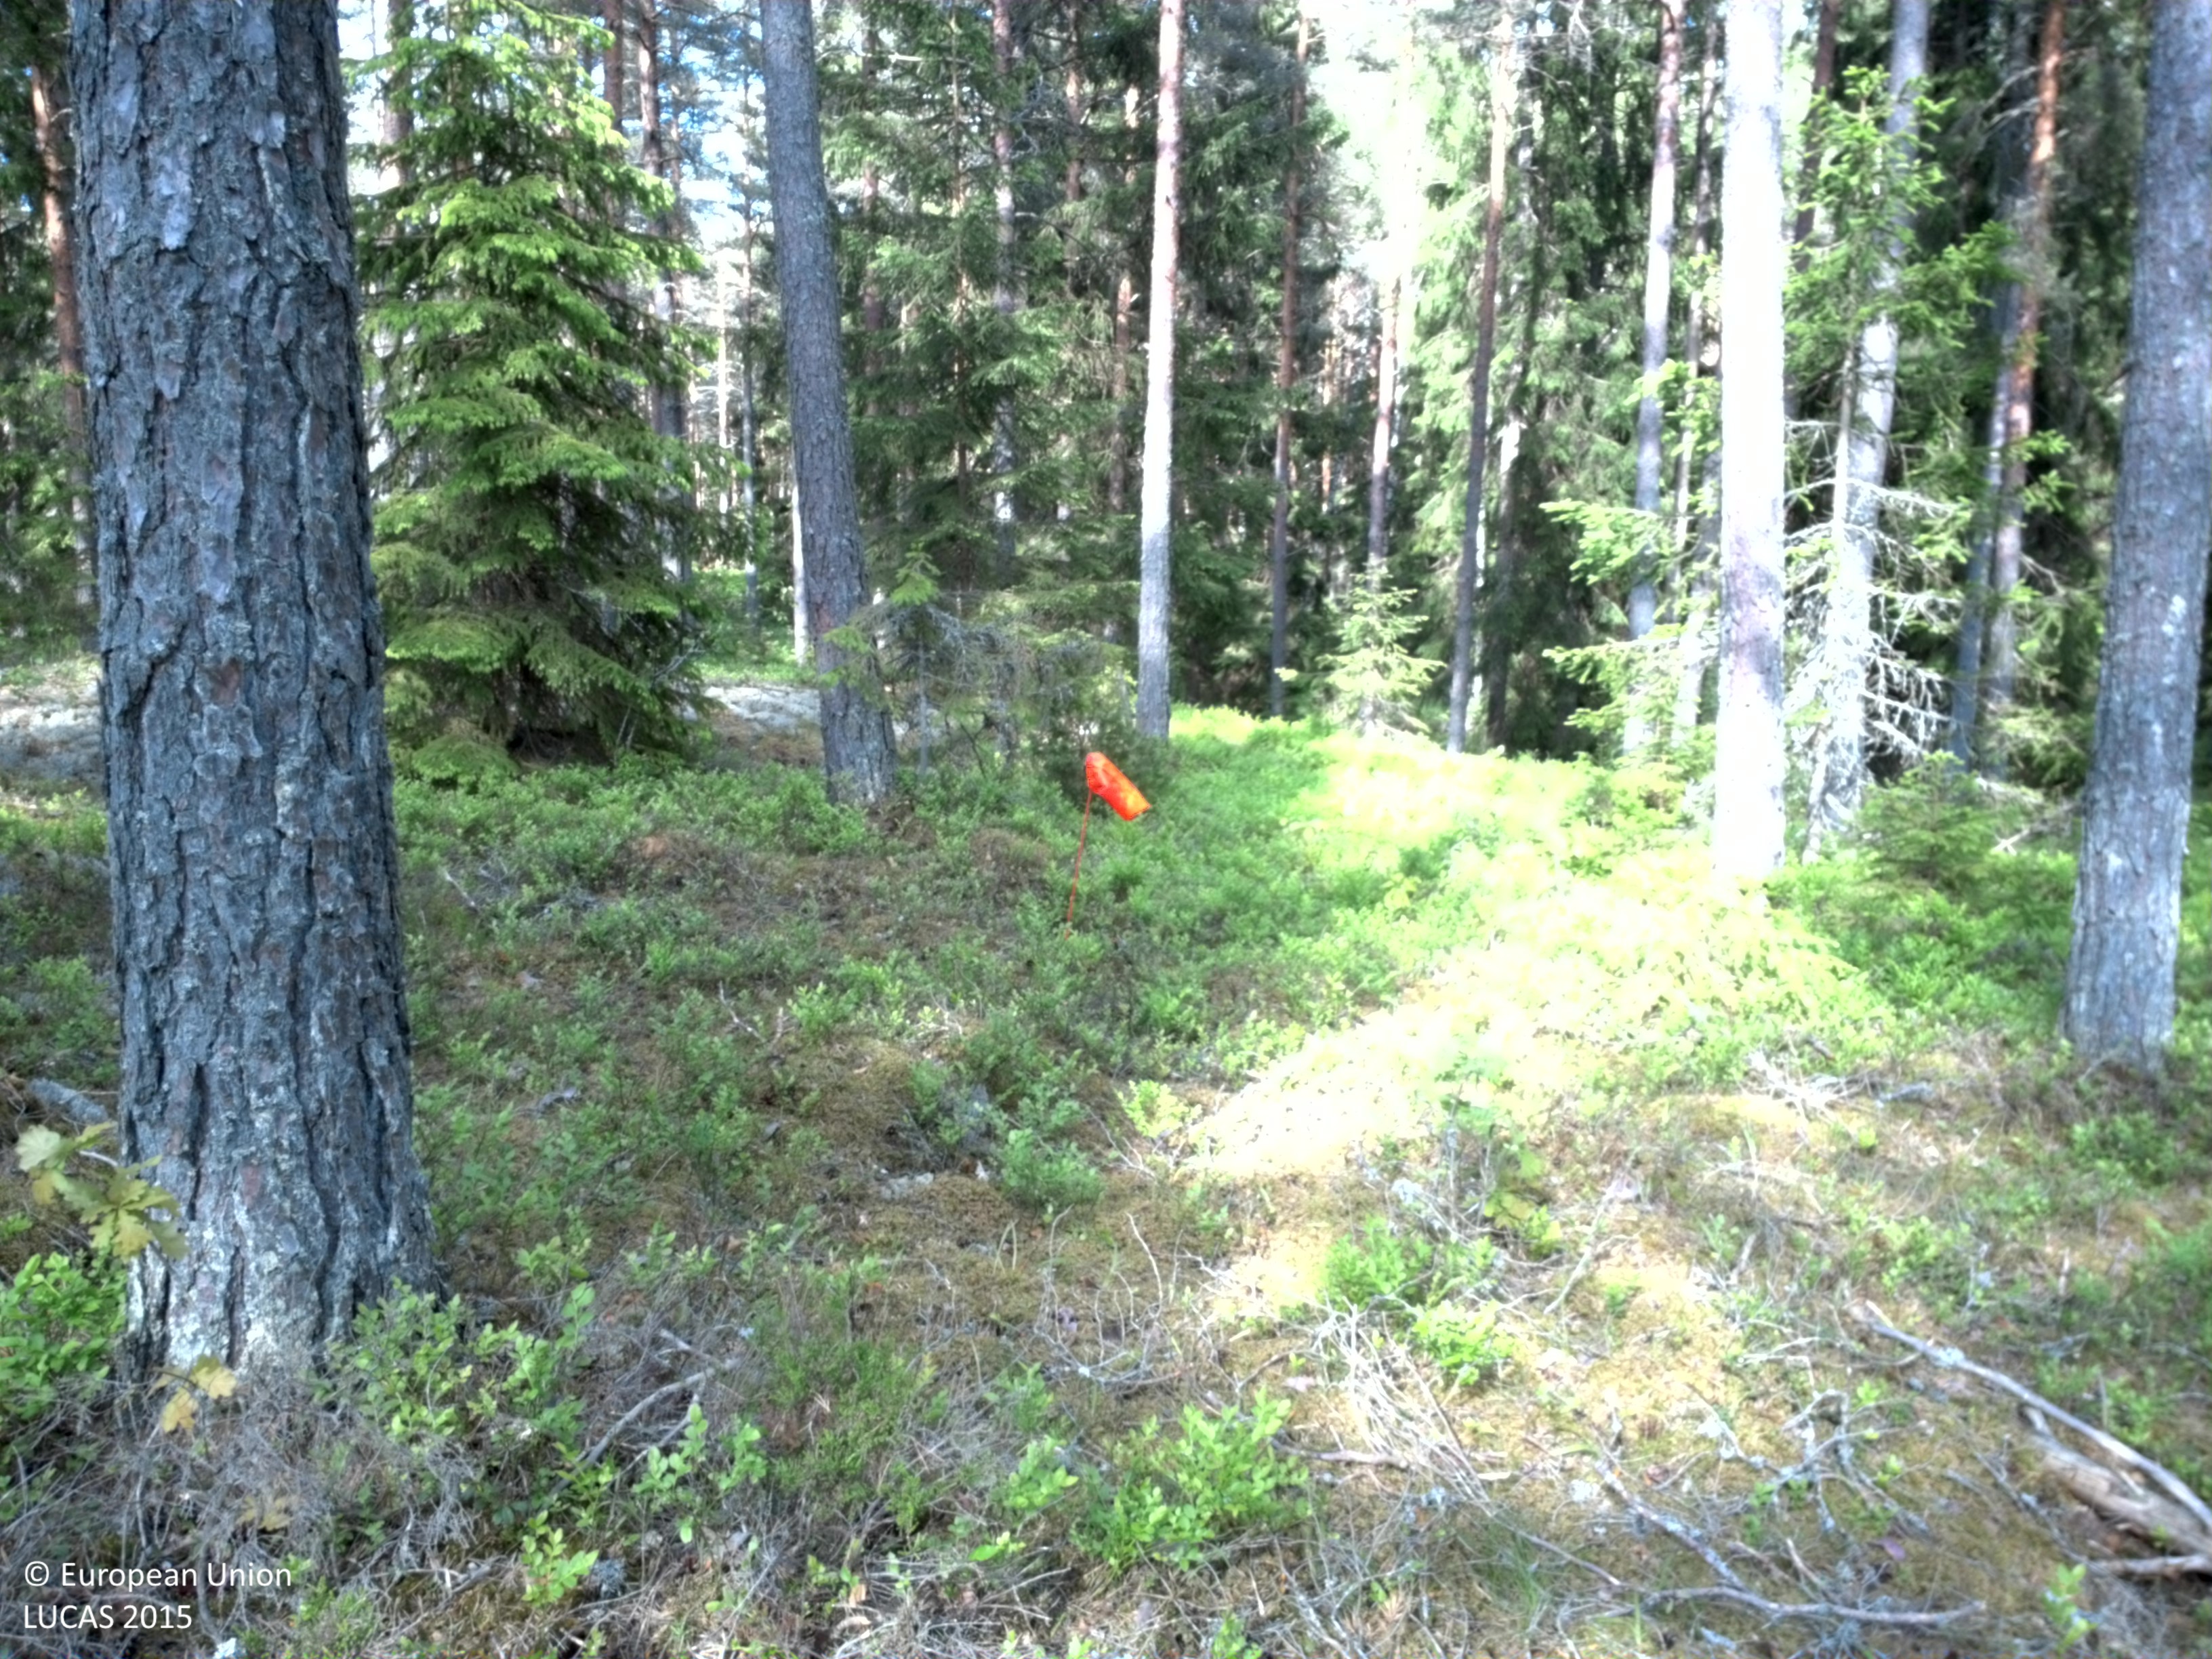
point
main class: Woodland
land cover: Pine dominated coniferous woodland
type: boreal forest
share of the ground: 25 - 50 %
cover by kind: herbaceous plants 45 %, coniferous forest trees 40 %, lichens and mosses 15 %
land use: Forestry
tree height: > 5 m
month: June
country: SE
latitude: 58.3963
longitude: 16.3091
